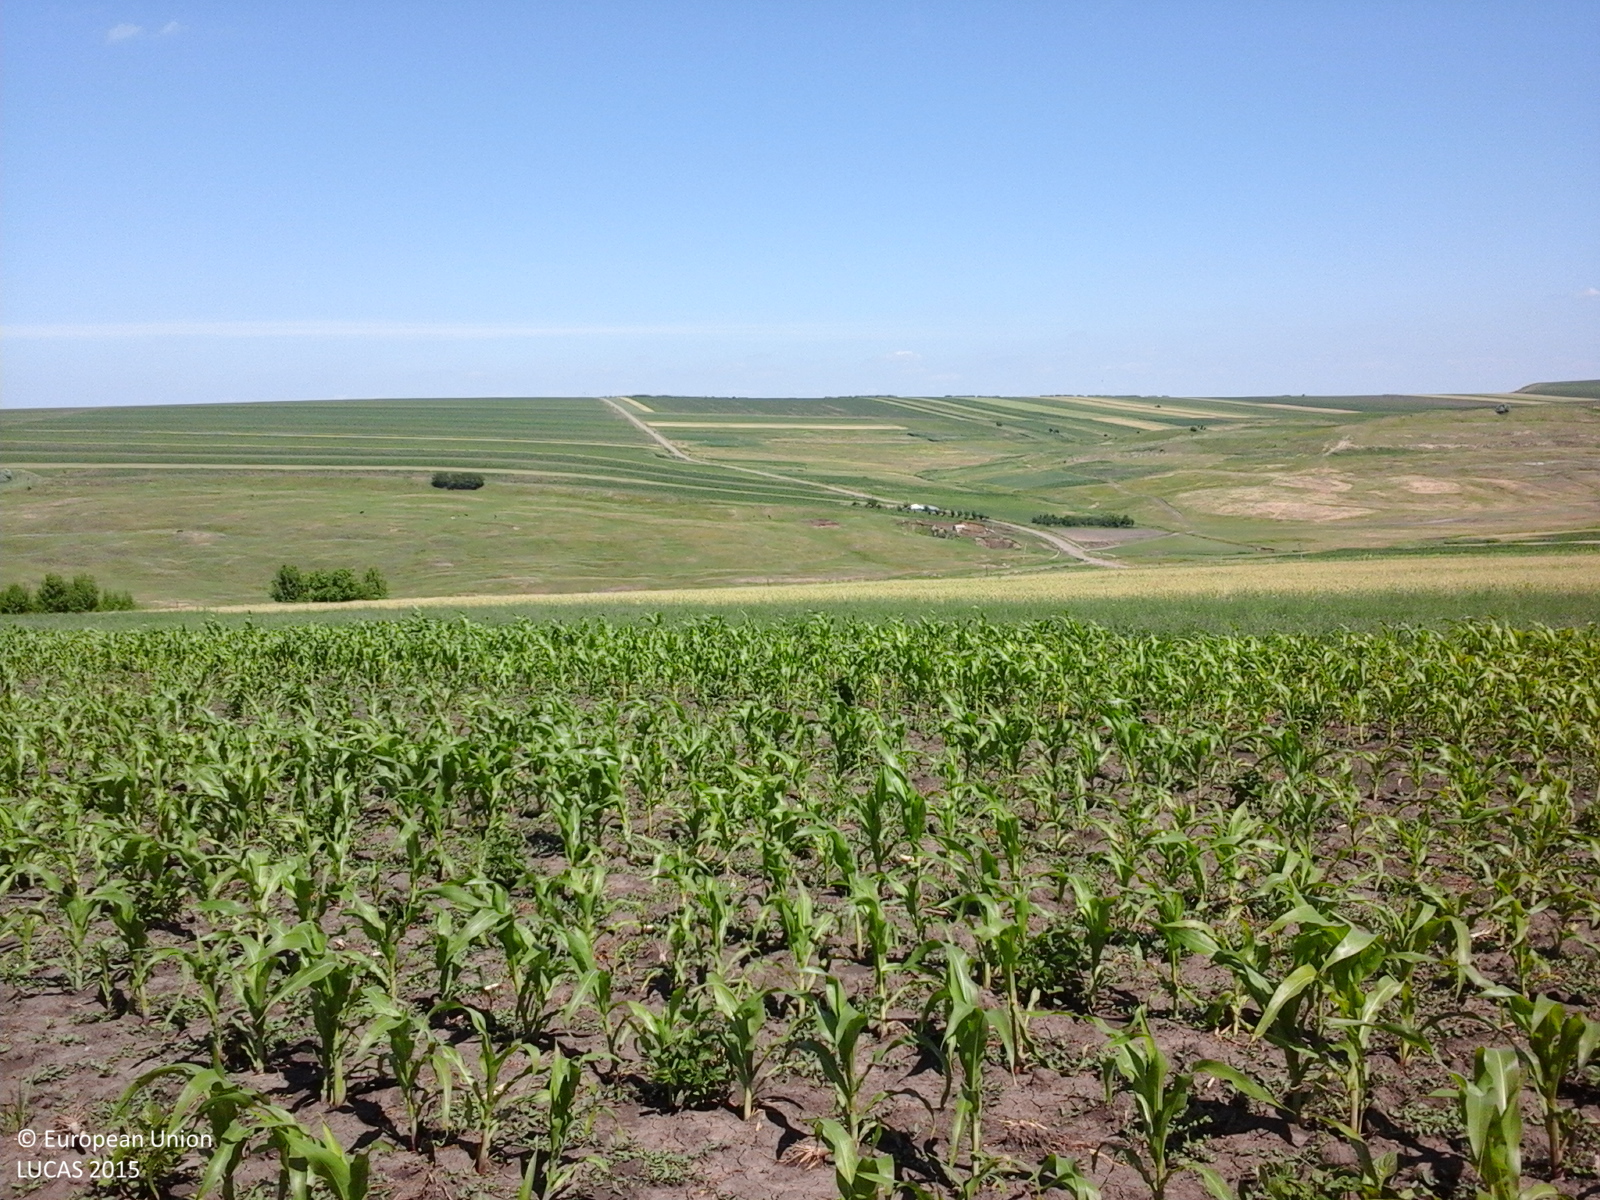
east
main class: Cropland
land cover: Maize
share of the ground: 25 - 50 %
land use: Agriculture (excluding fallow land and kitchen gardens)
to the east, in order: Maize; Lucerne; Common wheat; Spontaneously vegetated surfaces; Grassland without tree/shrub cover
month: June
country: RO
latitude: 47.4751
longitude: 27.0215
